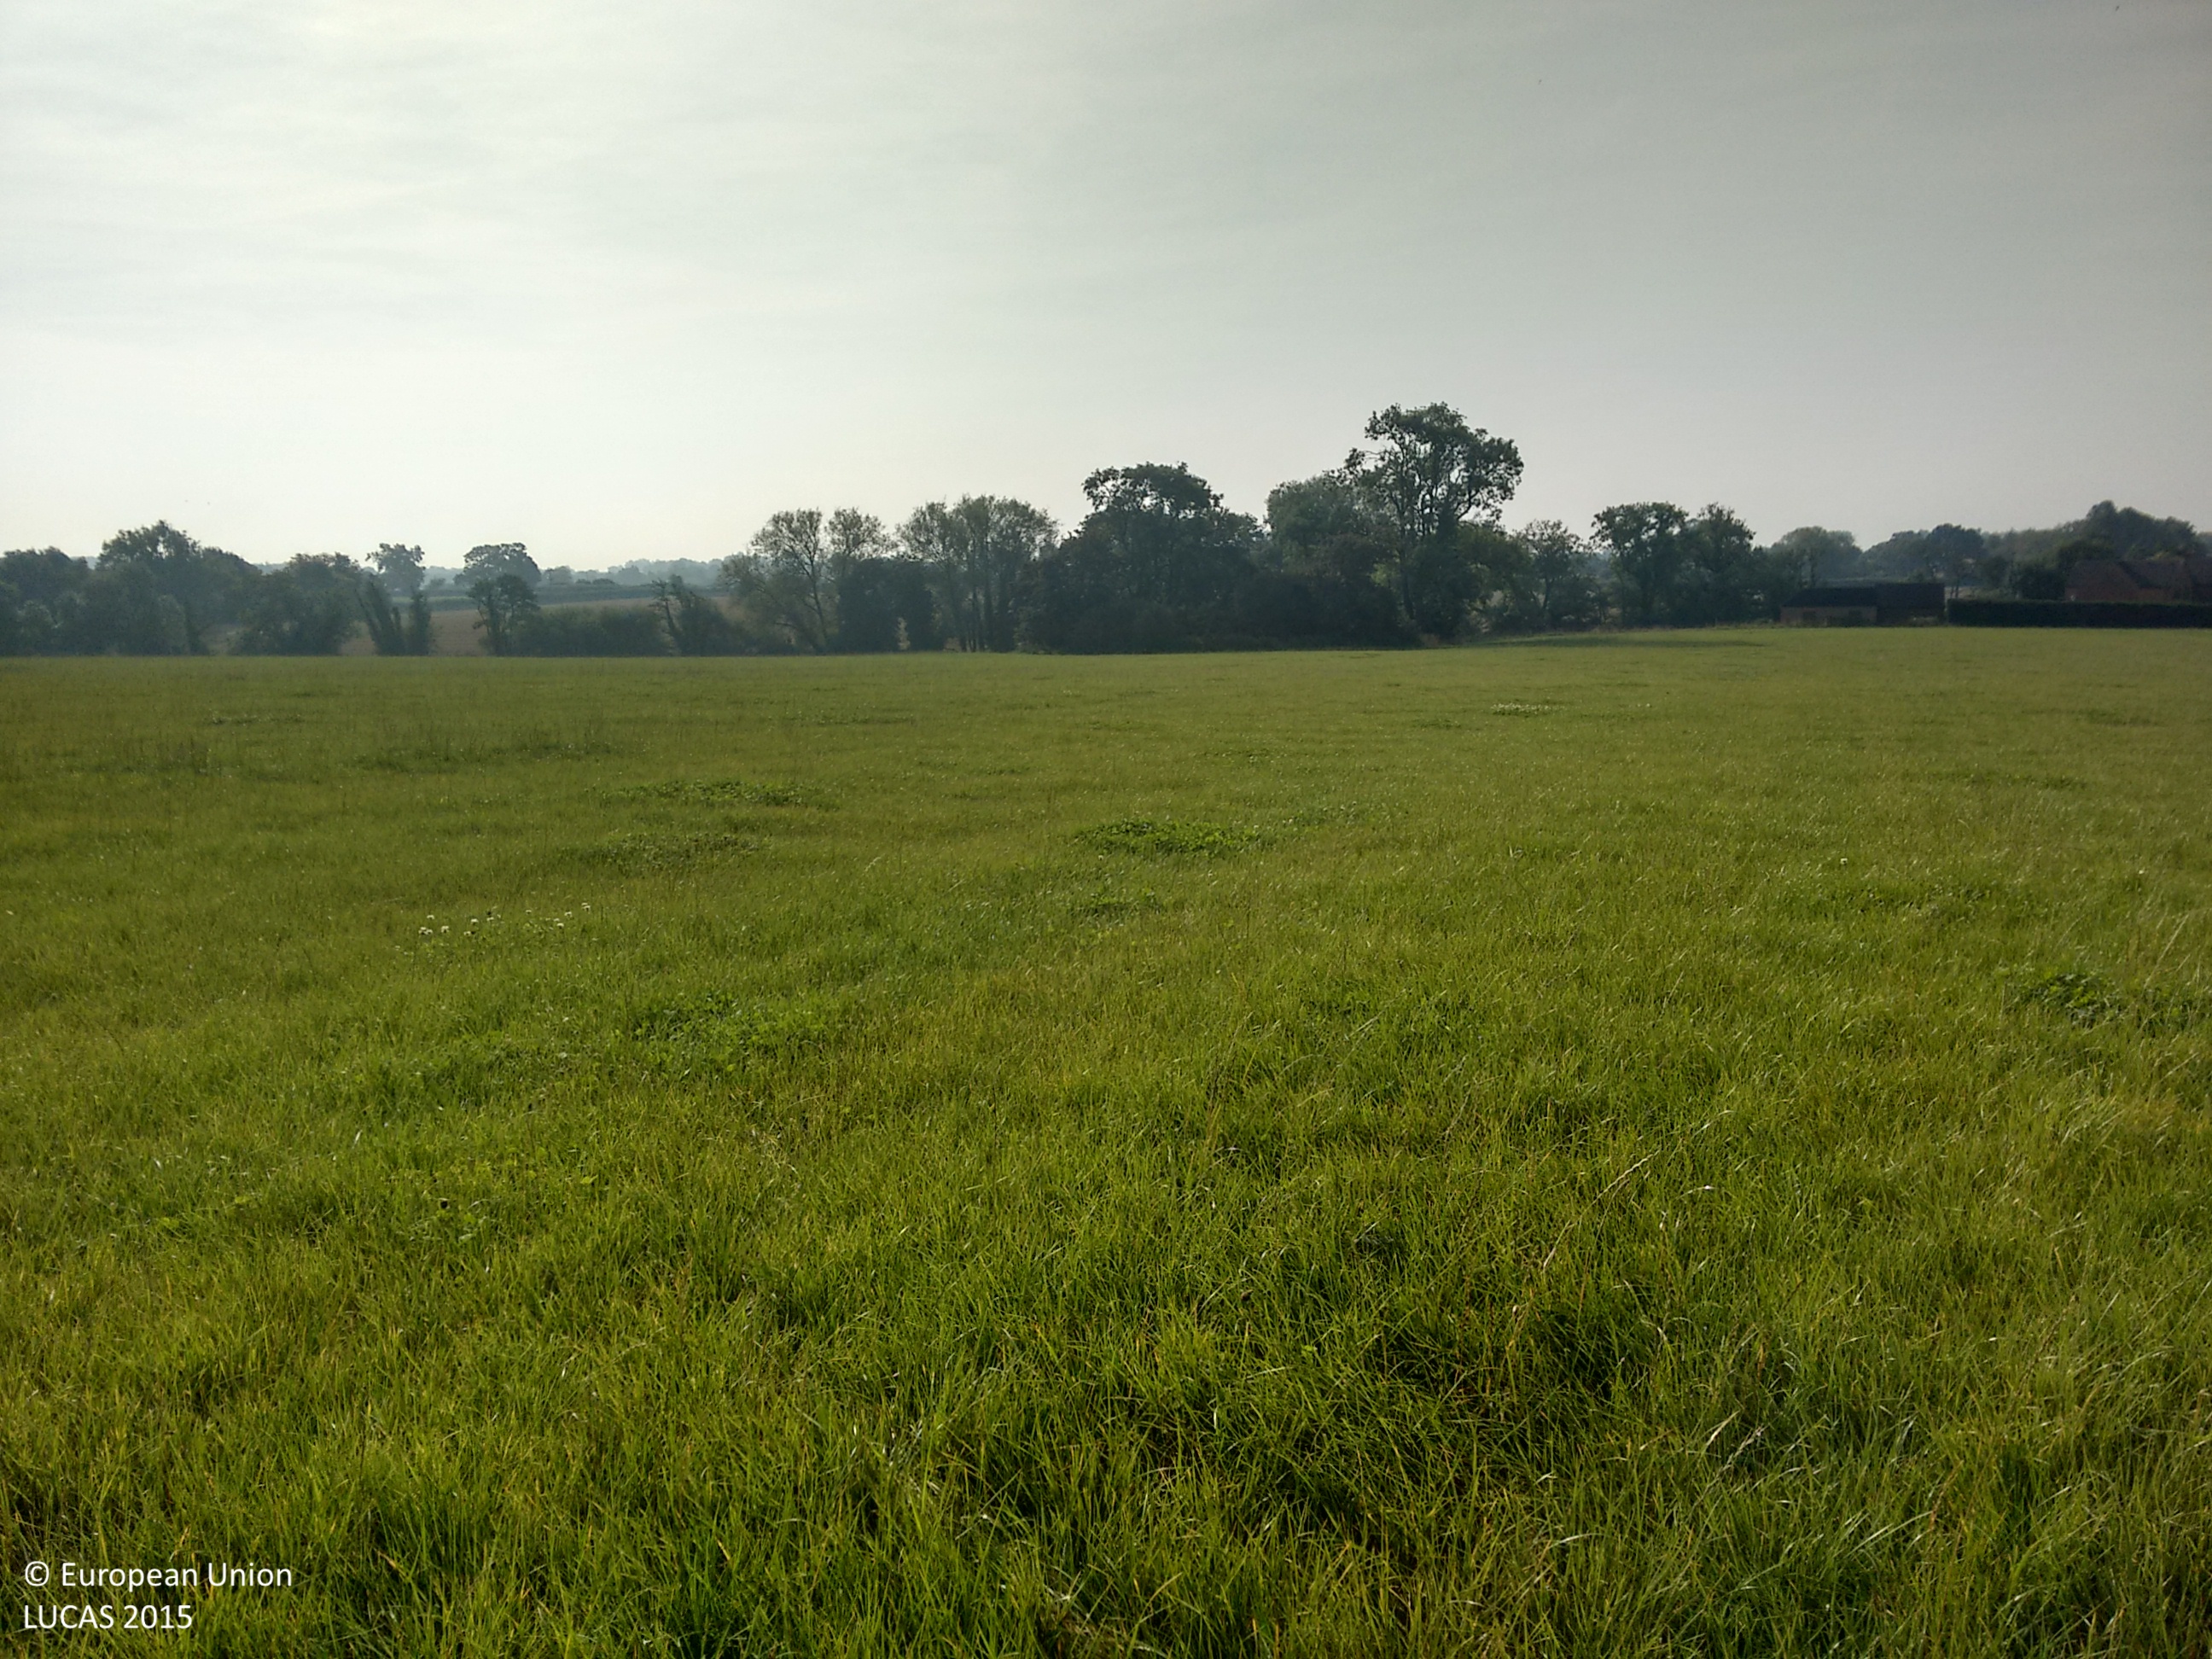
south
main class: Grassland
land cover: Grassland without tree/shrub cover
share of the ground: > 75 %
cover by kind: herbaceous plants 100 %
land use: Agriculture (excluding fallow land and kitchen gardens)
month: September
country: GB
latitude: 52.8405
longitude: -2.3410
